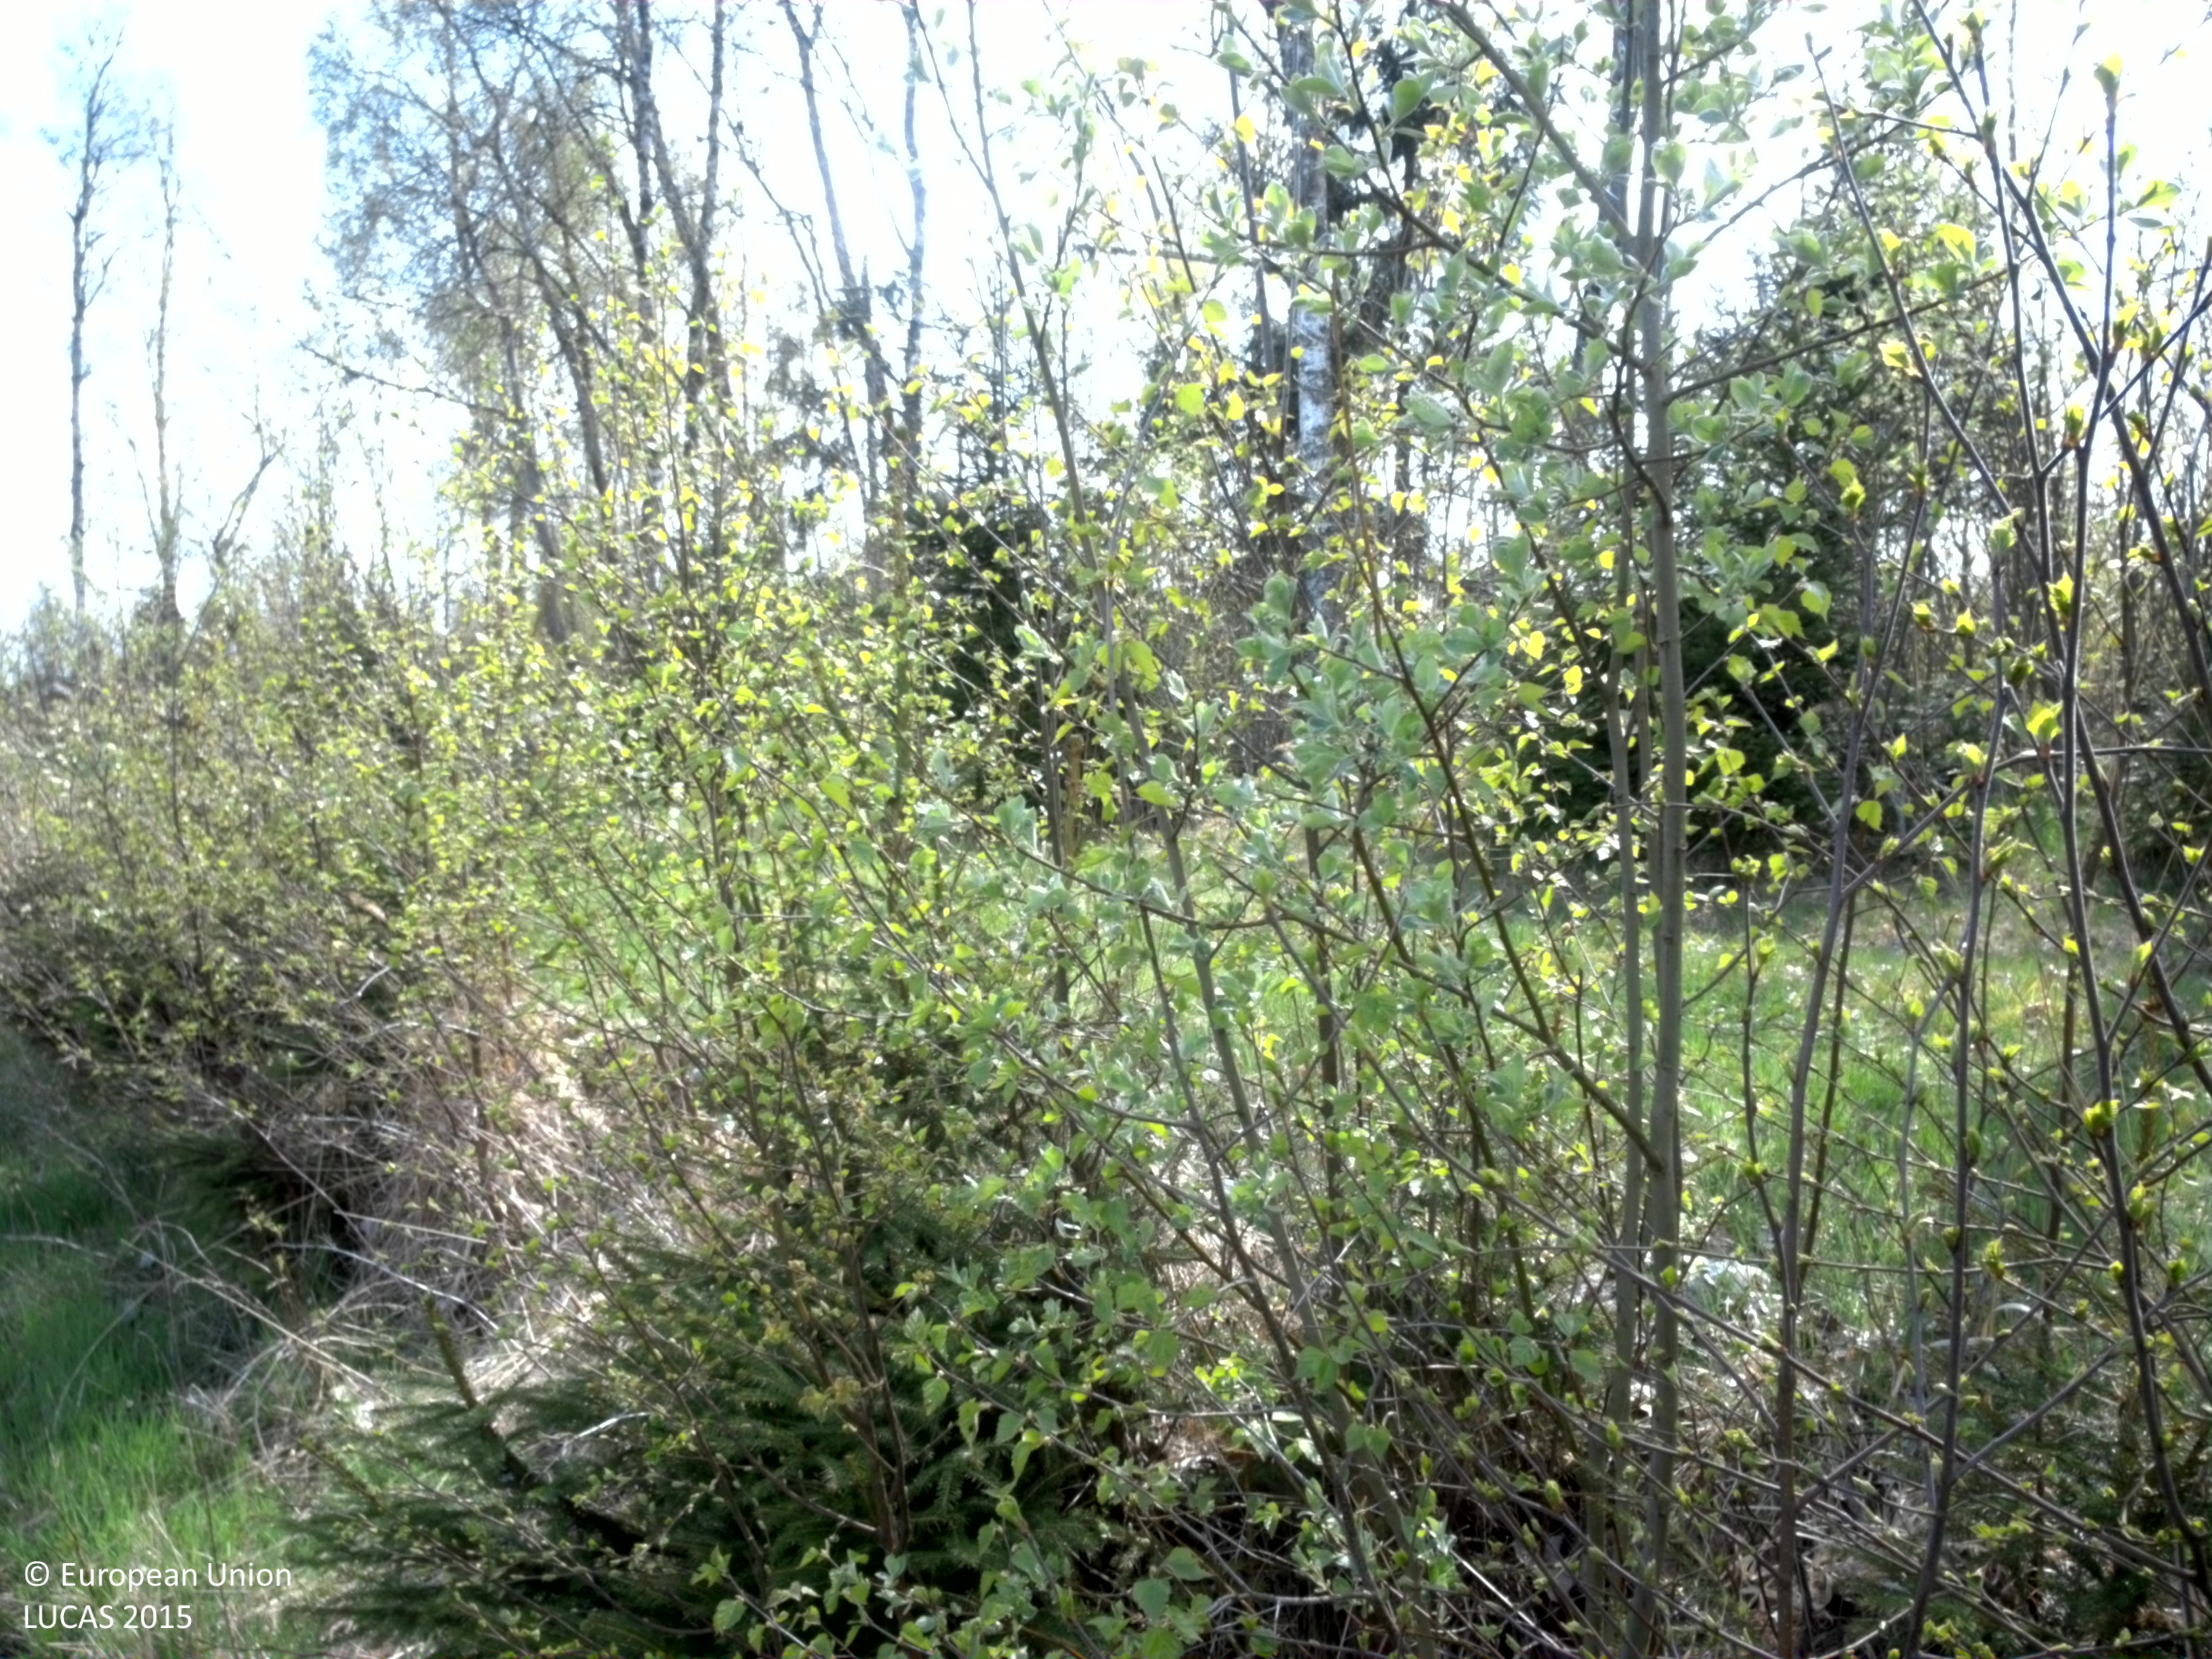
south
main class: Cropland
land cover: Rye
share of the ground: < 10 %
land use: Agriculture (excluding fallow land and kitchen gardens)
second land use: Amenities, museums, leisure
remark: Tilled/Sowed
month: May
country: SE
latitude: 56.7266
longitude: 14.8513
